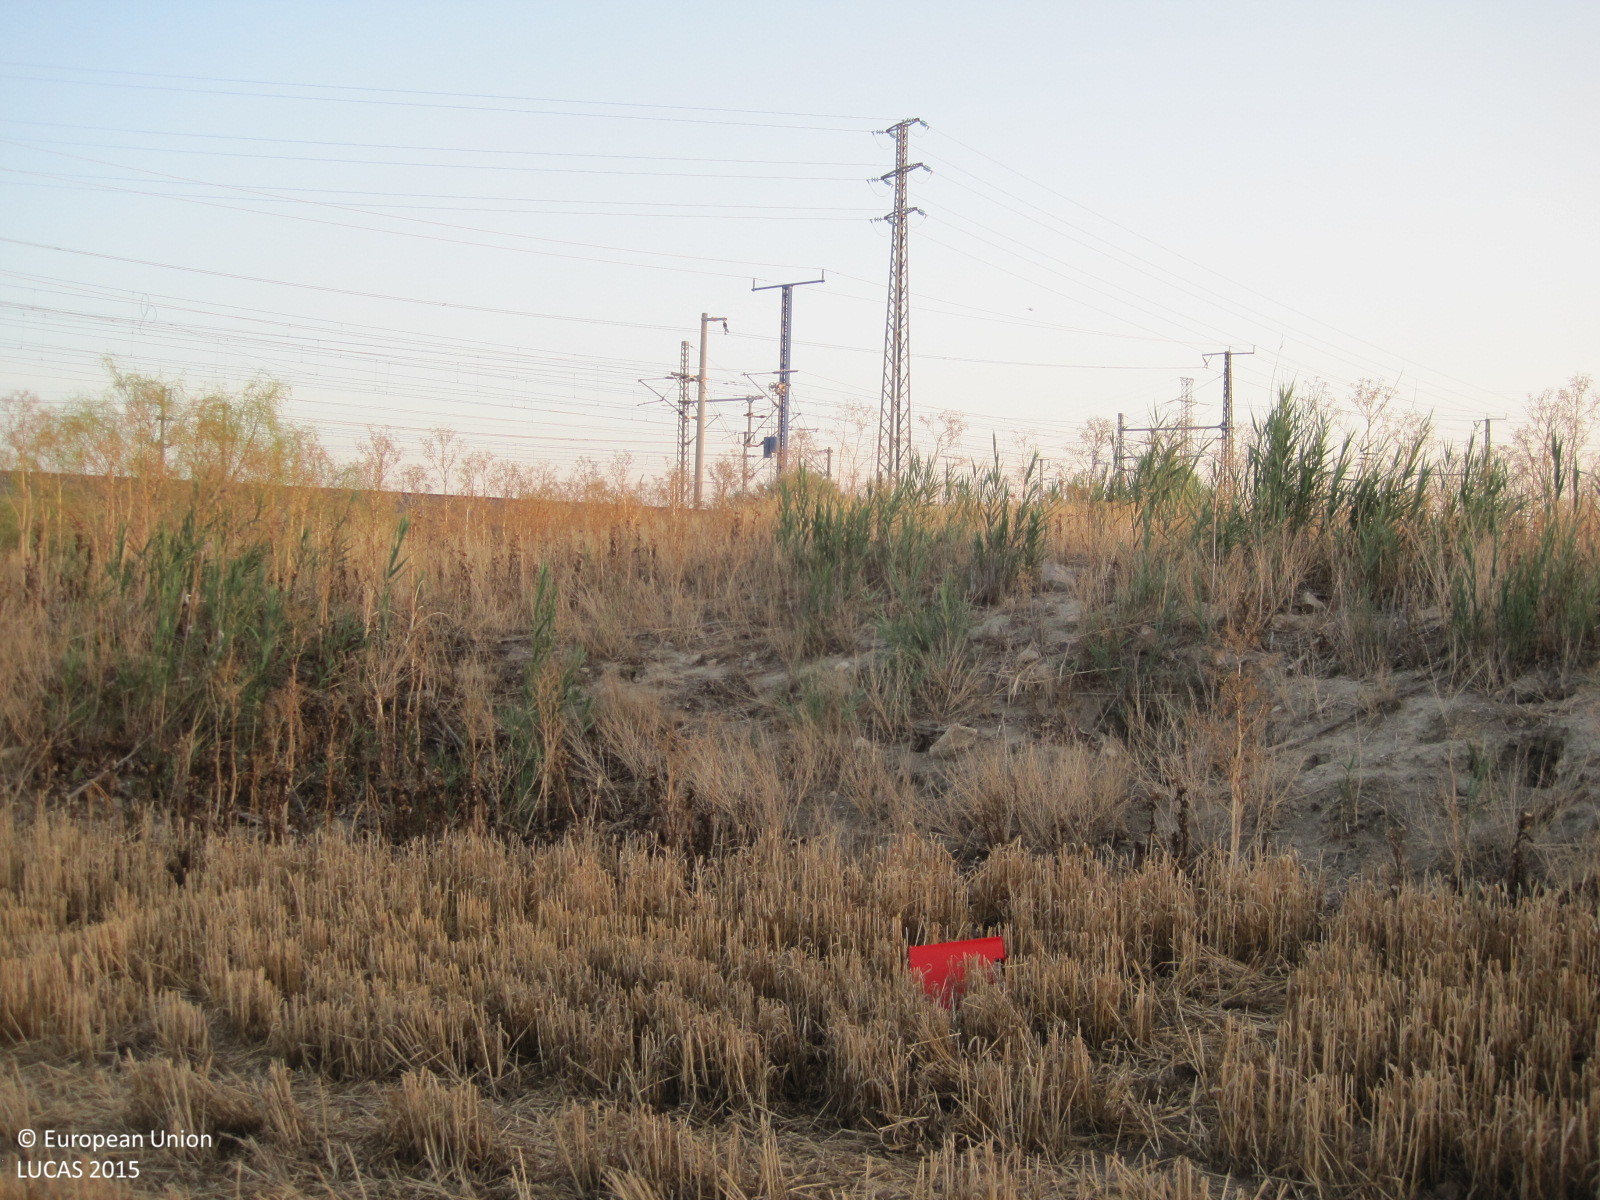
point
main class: Cropland
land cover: Triticale
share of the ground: < 10 %
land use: Agriculture (excluding fallow land and kitchen gardens)
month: July
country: ES
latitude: 39.9778
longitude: -3.8390
